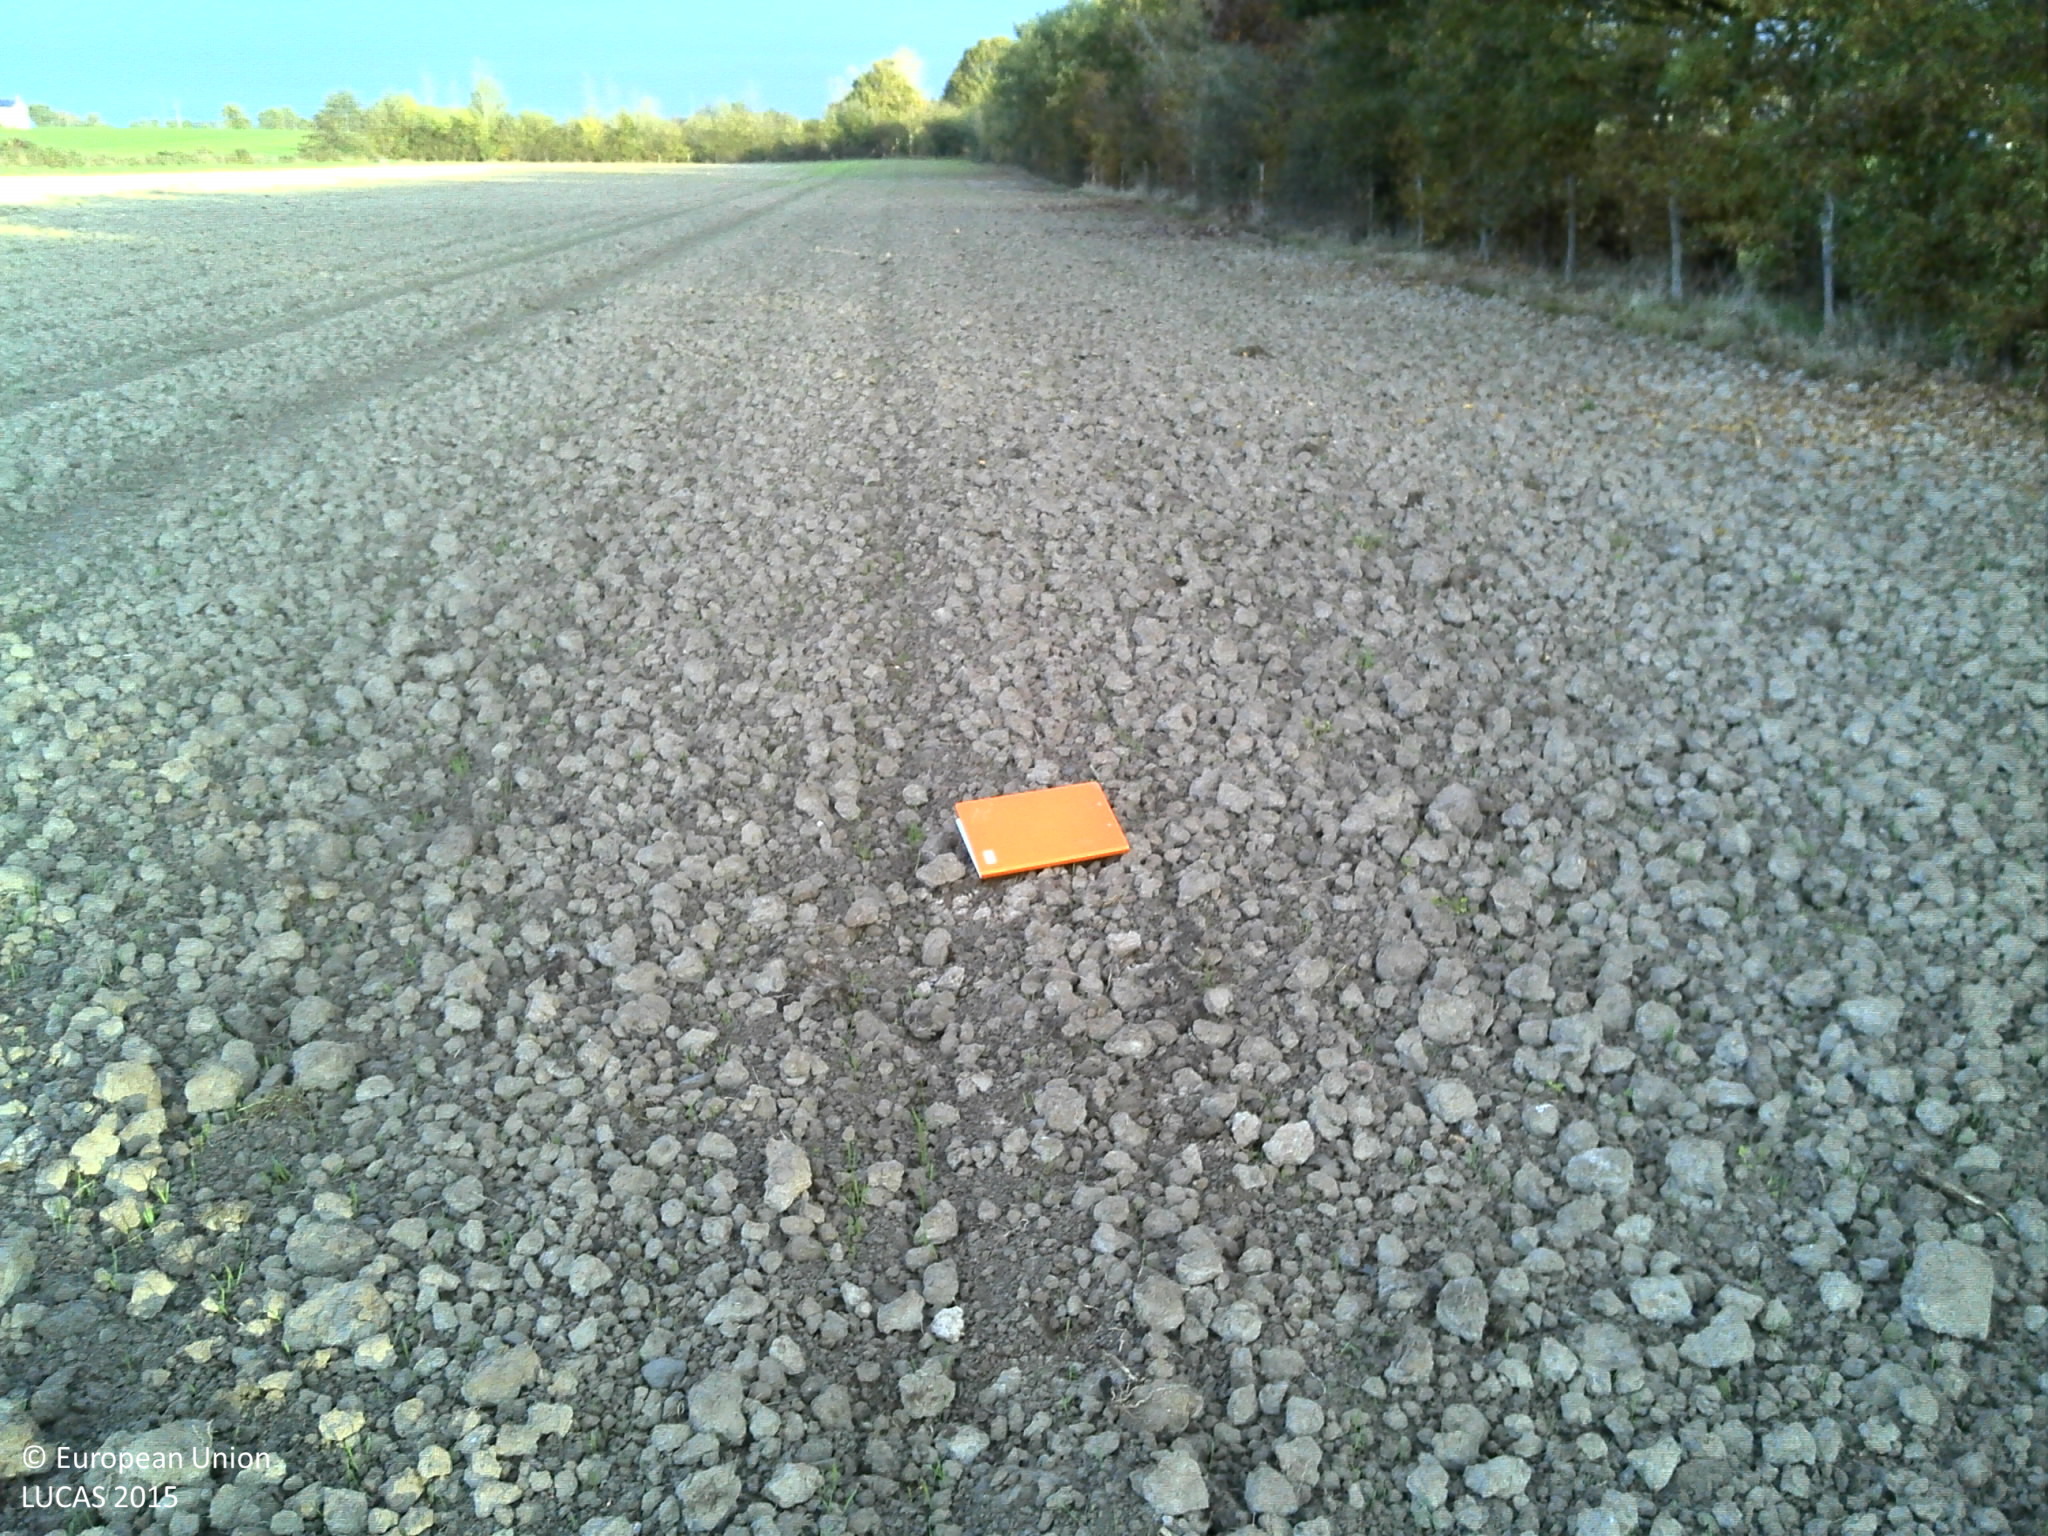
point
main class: Cropland
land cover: Common wheat
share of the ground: < 10 %
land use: Agriculture (excluding fallow land and kitchen gardens)
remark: Tilled/Sowed
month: November
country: FR
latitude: 47.5772
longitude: -1.0321
